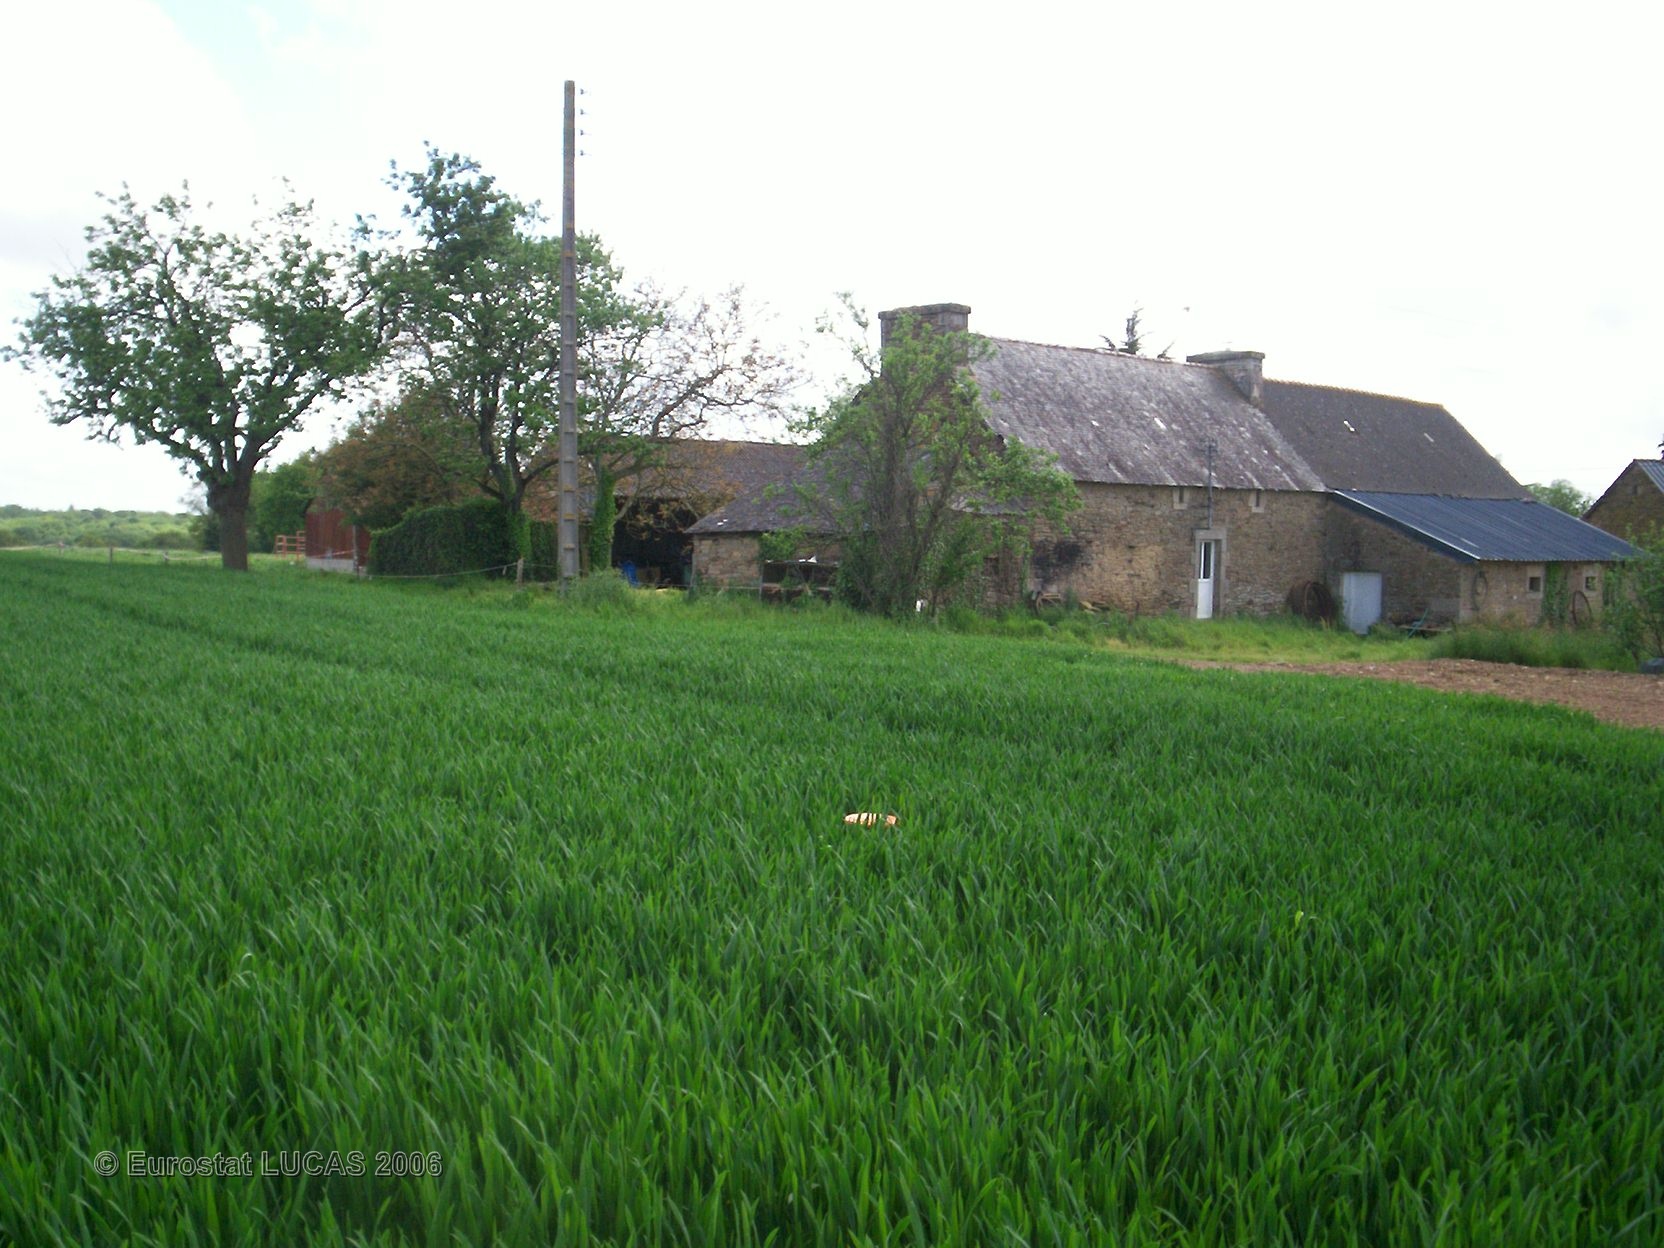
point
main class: Cropland
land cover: Common wheat
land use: Agriculture (excluding fallow land and kitchen gardens)
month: May
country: FR
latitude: 47.9008
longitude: -2.7308
